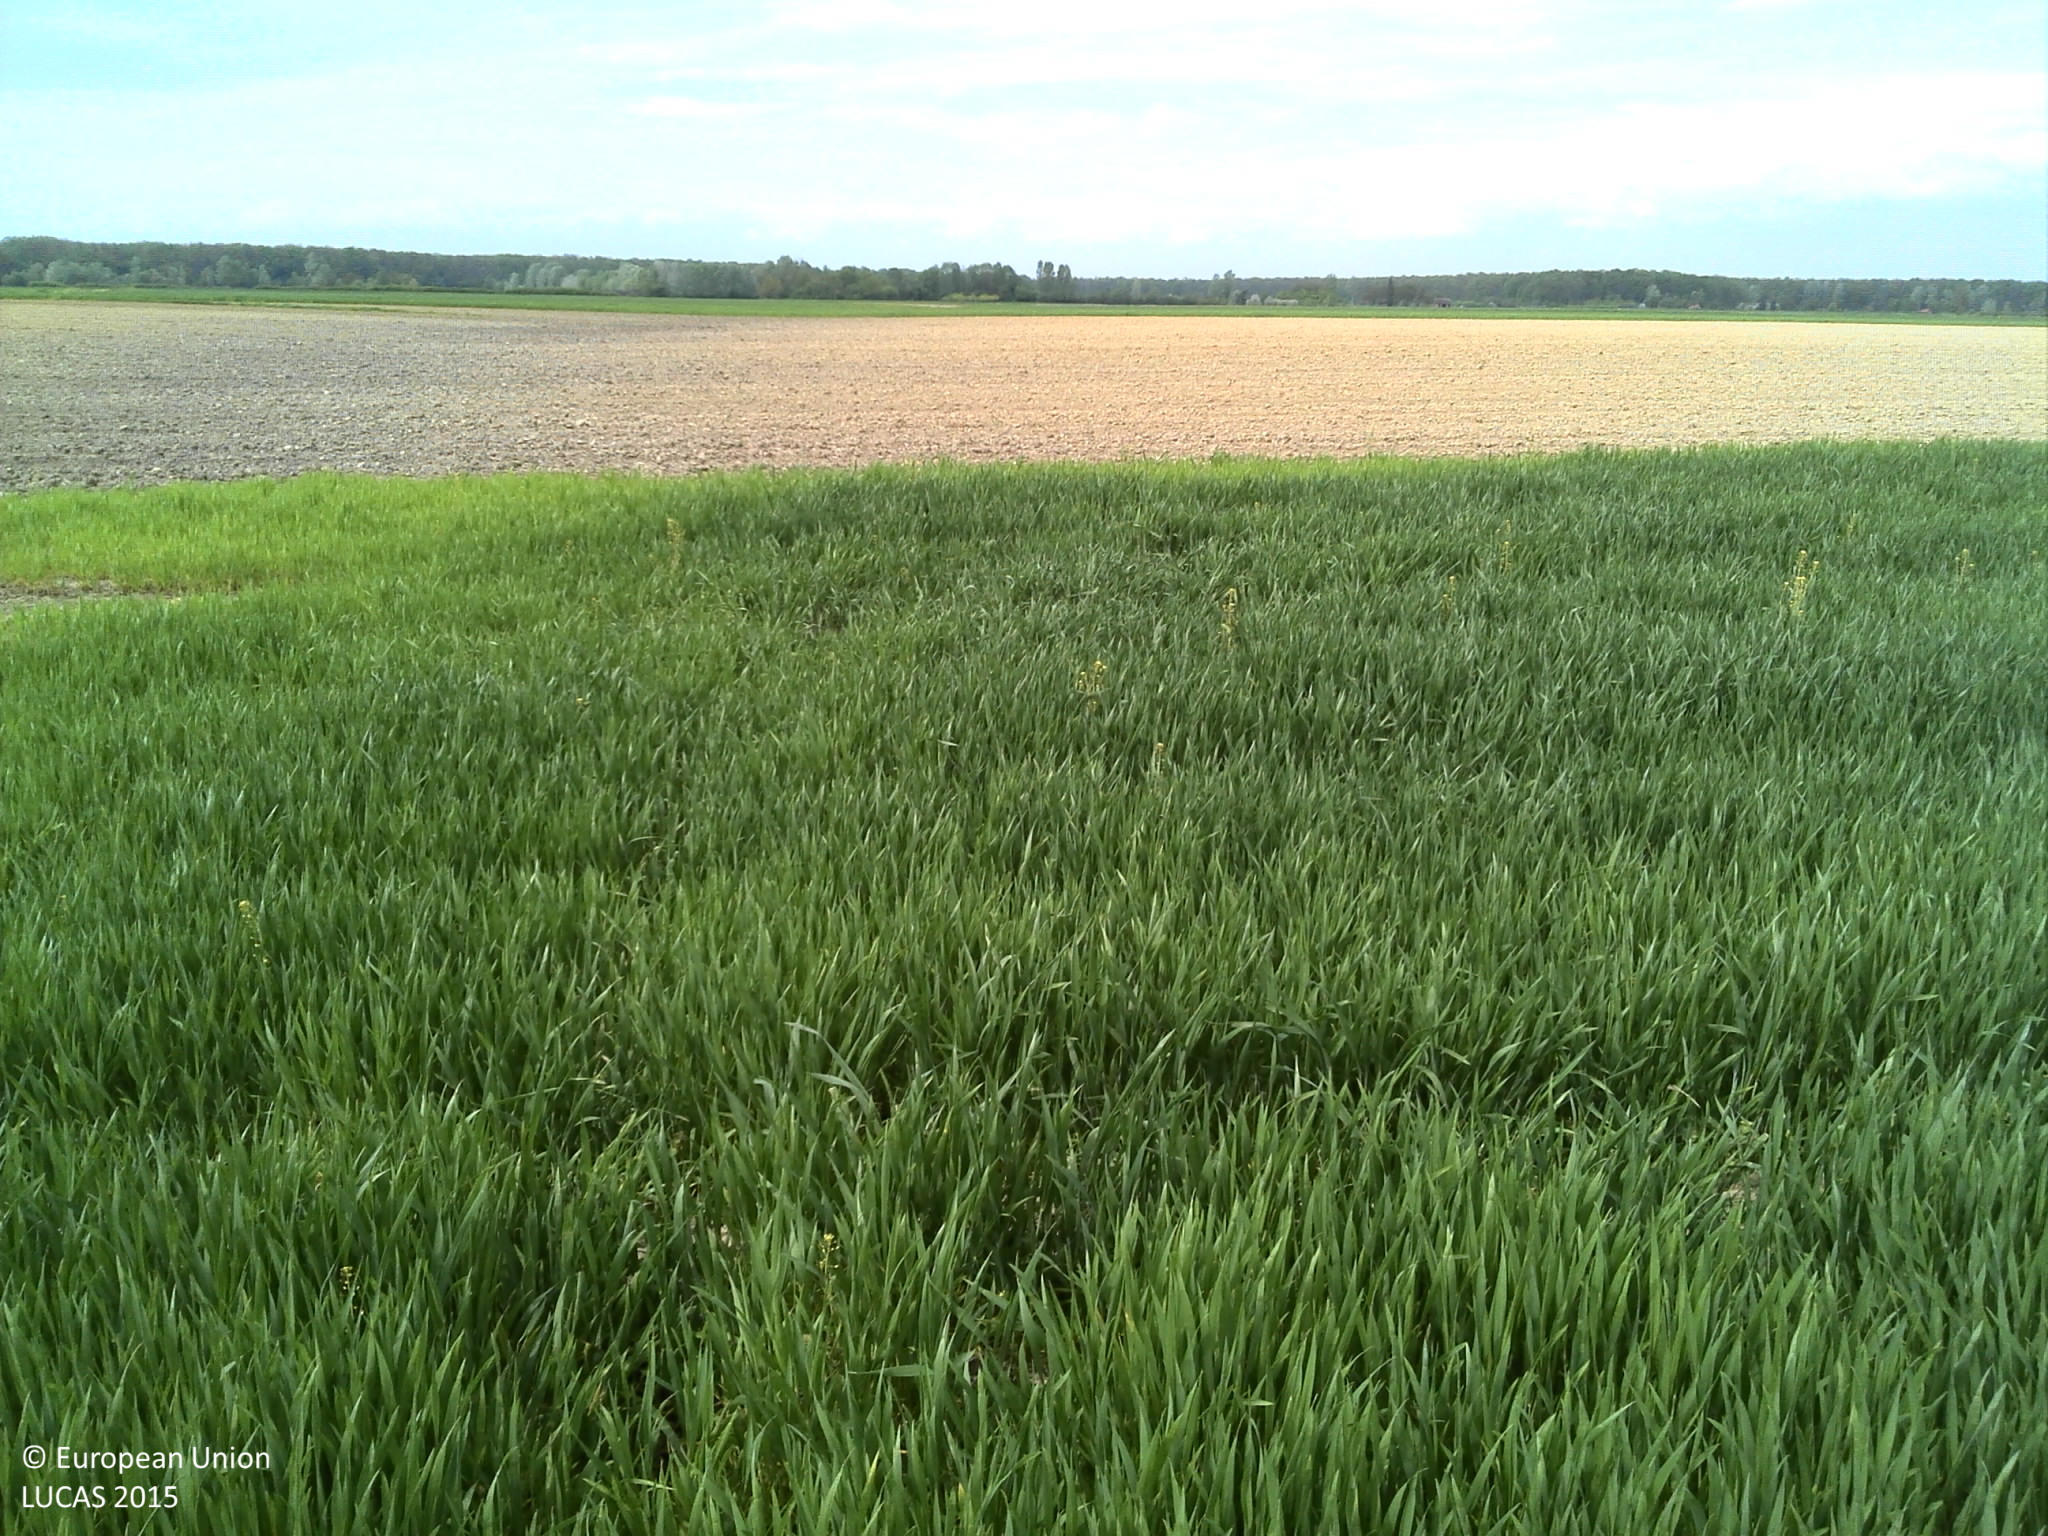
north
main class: Cropland
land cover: Common wheat
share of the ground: > 75 %
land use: Agriculture (excluding fallow land and kitchen gardens)
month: April
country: HR
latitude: 44.9989
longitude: 18.9246
